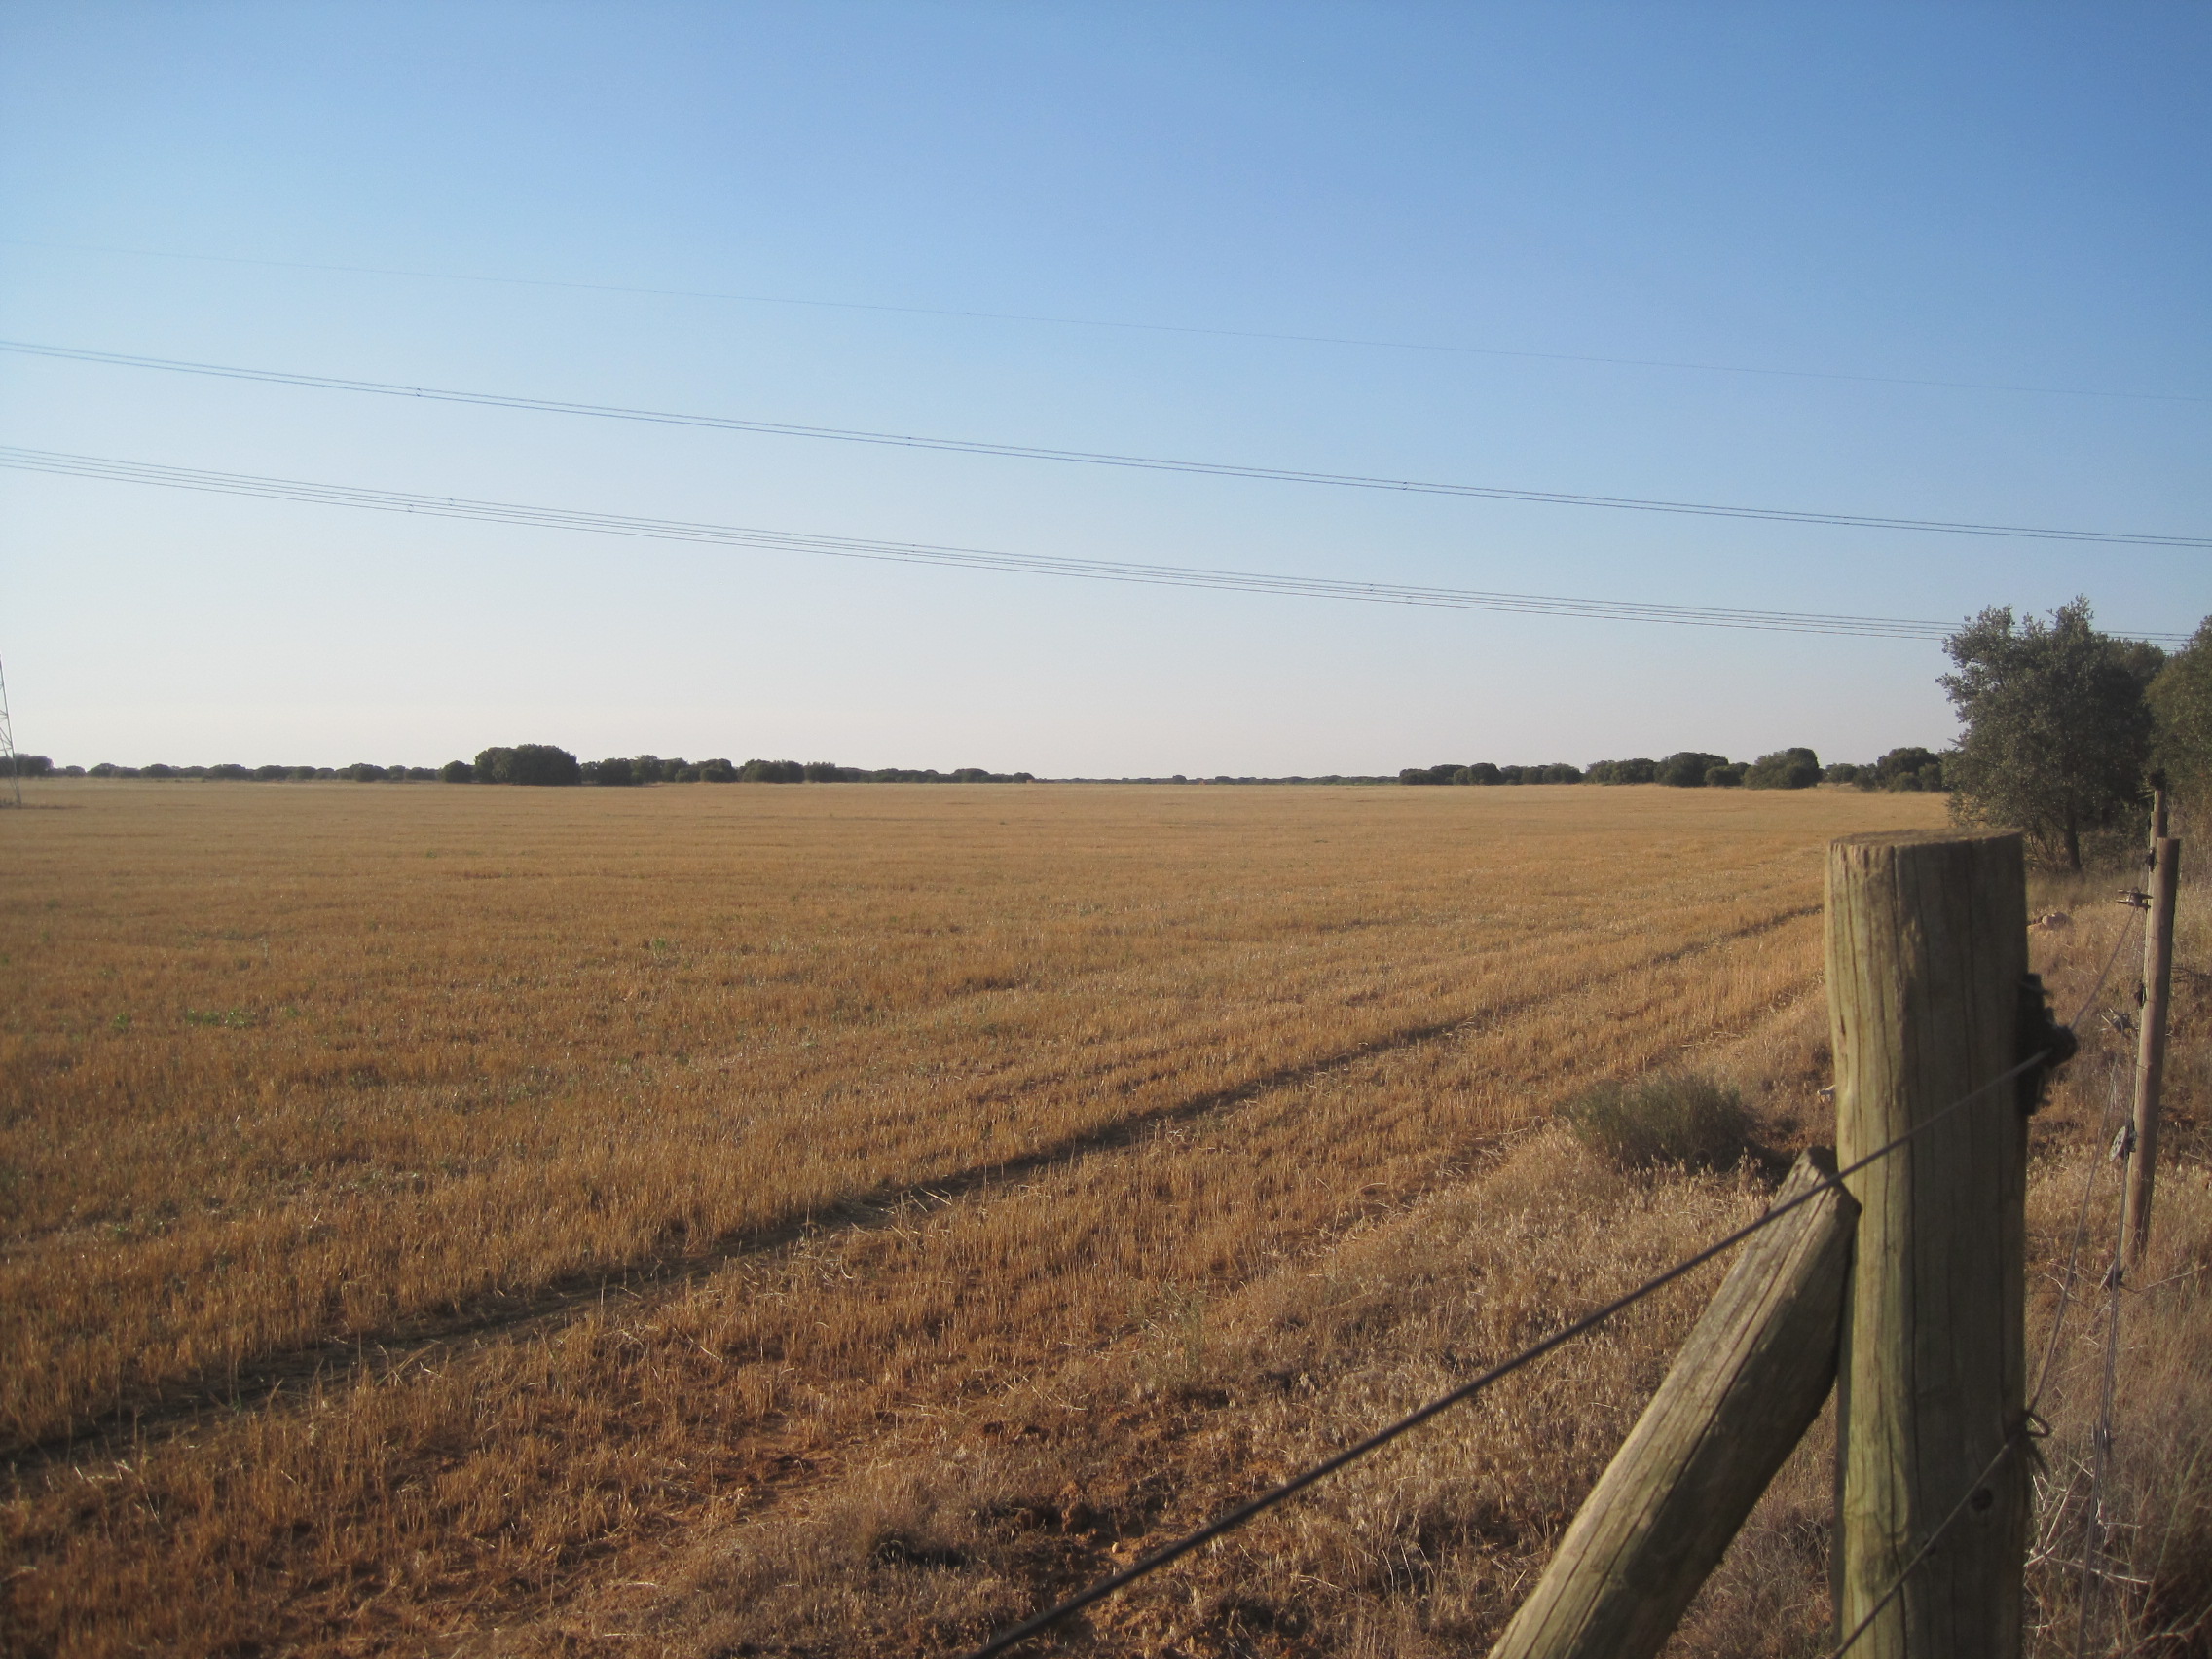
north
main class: Grassland
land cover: Grassland without tree/shrub cover
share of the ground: > 75 %
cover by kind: herbaceous plants 100 %
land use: Semi-natural and natural areas not in use
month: July
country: ES
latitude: 41.7107
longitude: -5.1365
